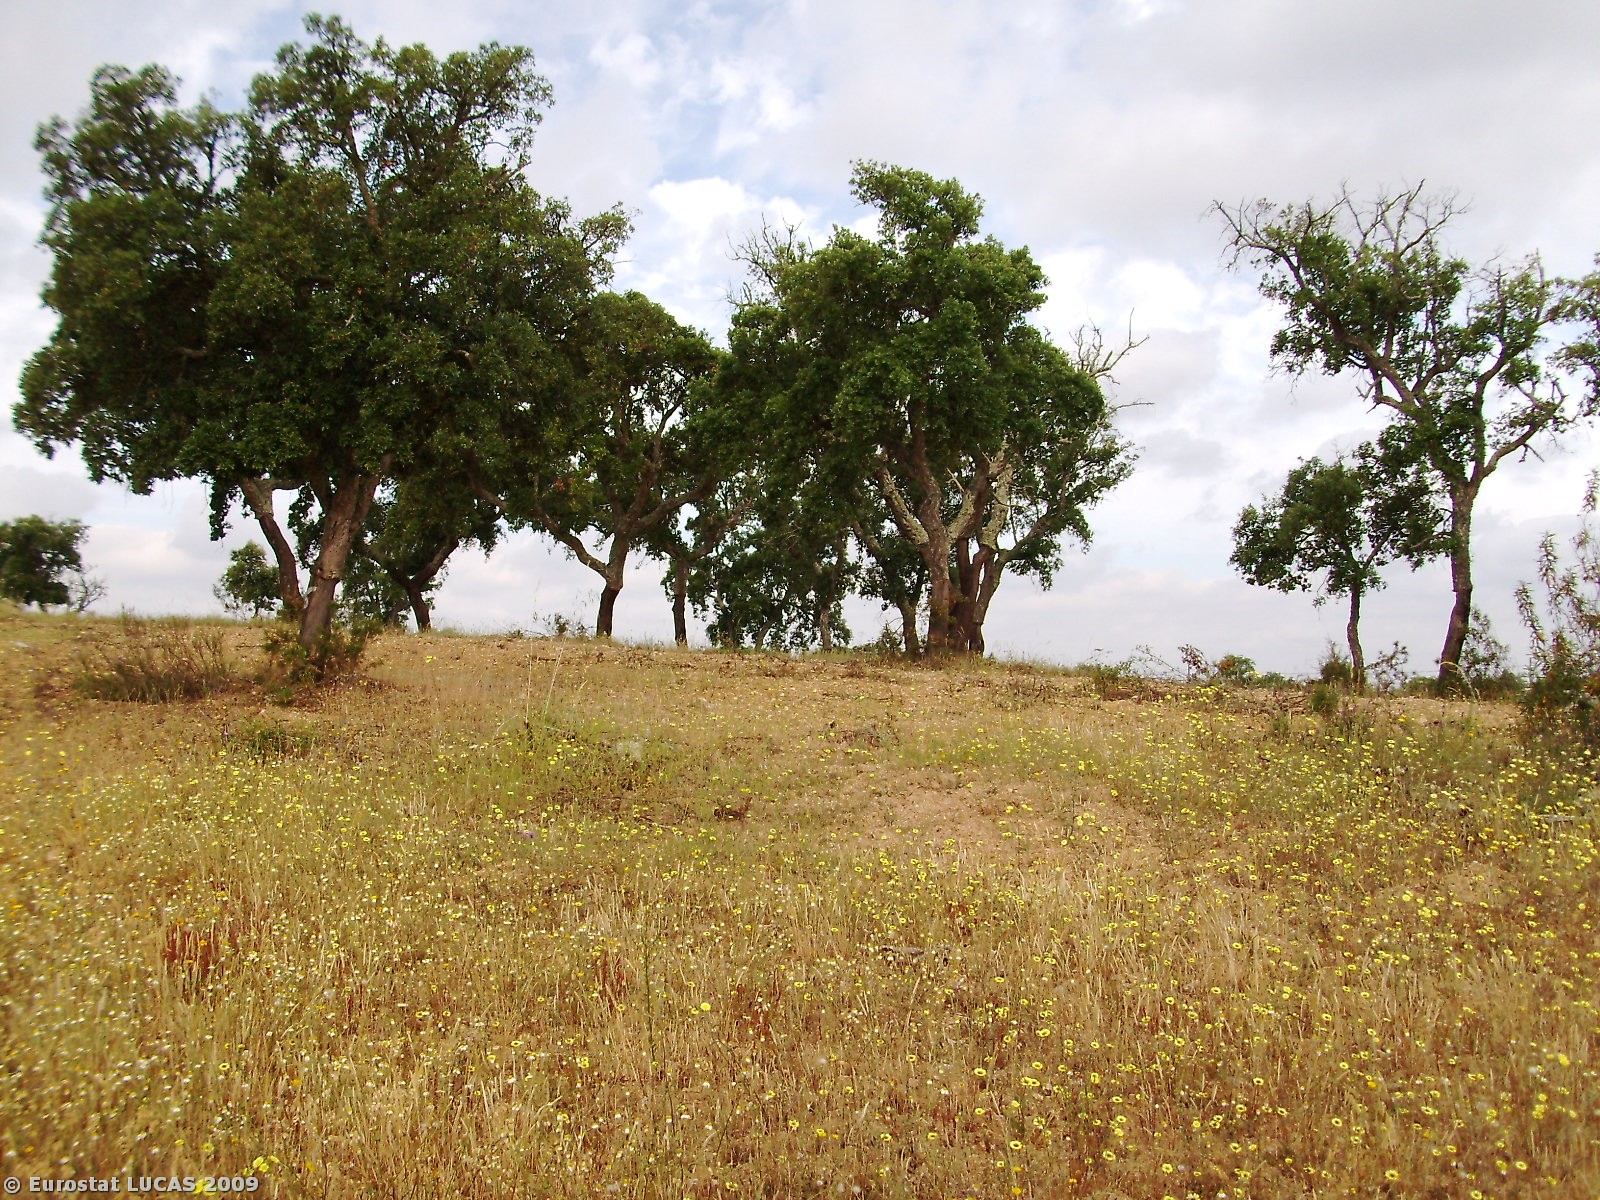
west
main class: Woodland
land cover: Broadleaved woodland
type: broadleaved evergreen forest
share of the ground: 50 - 75 %
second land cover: Spontaneously vegetated surfaces
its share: 25 - 50 %
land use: Forestry
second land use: Fallow land
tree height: > 5 m
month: May
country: PT
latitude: 39.0058
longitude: -7.9357
